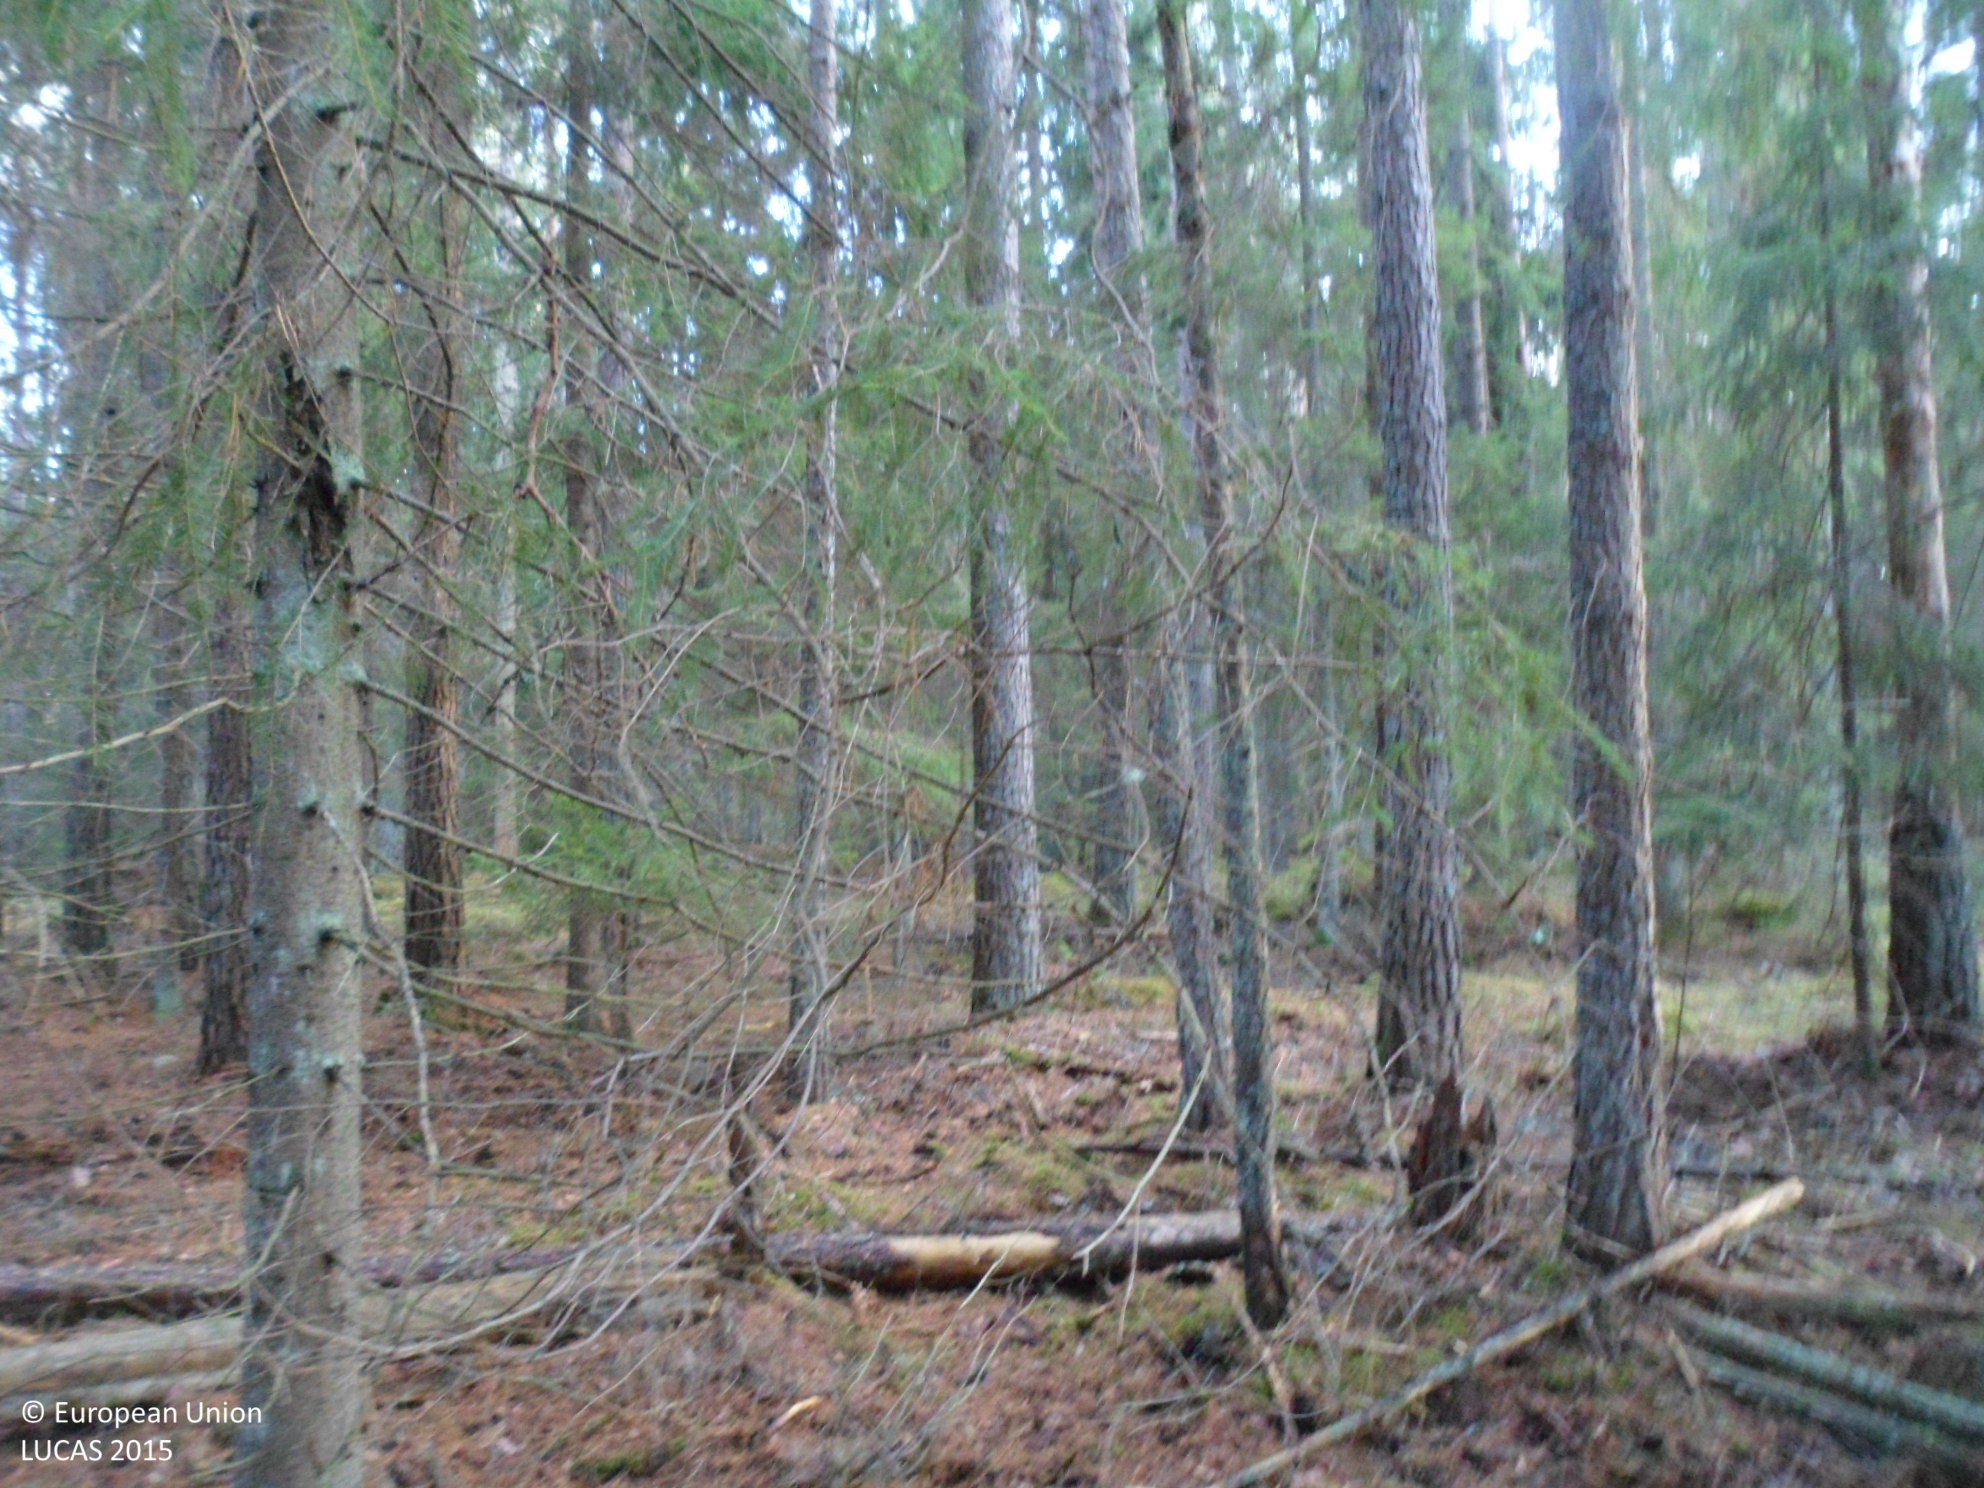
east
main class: Woodland
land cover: Other coniferous woodland
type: boreal forest
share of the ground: 50 - 75 %
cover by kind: coniferous forest trees 60 %, lichens and mosses 20 %, shrubs 15 %, unconsolidated bare surface 5 %
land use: Forestry
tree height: > 5 m
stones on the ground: 10 - 25 %
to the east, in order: Other coniferous woodland; Pine dominated coniferous woodland; Rivers and streams; Pine dominated mixed woodland; Spruce dominated coniferous woodland
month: November
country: SE
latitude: 56.9118
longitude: 16.0269
